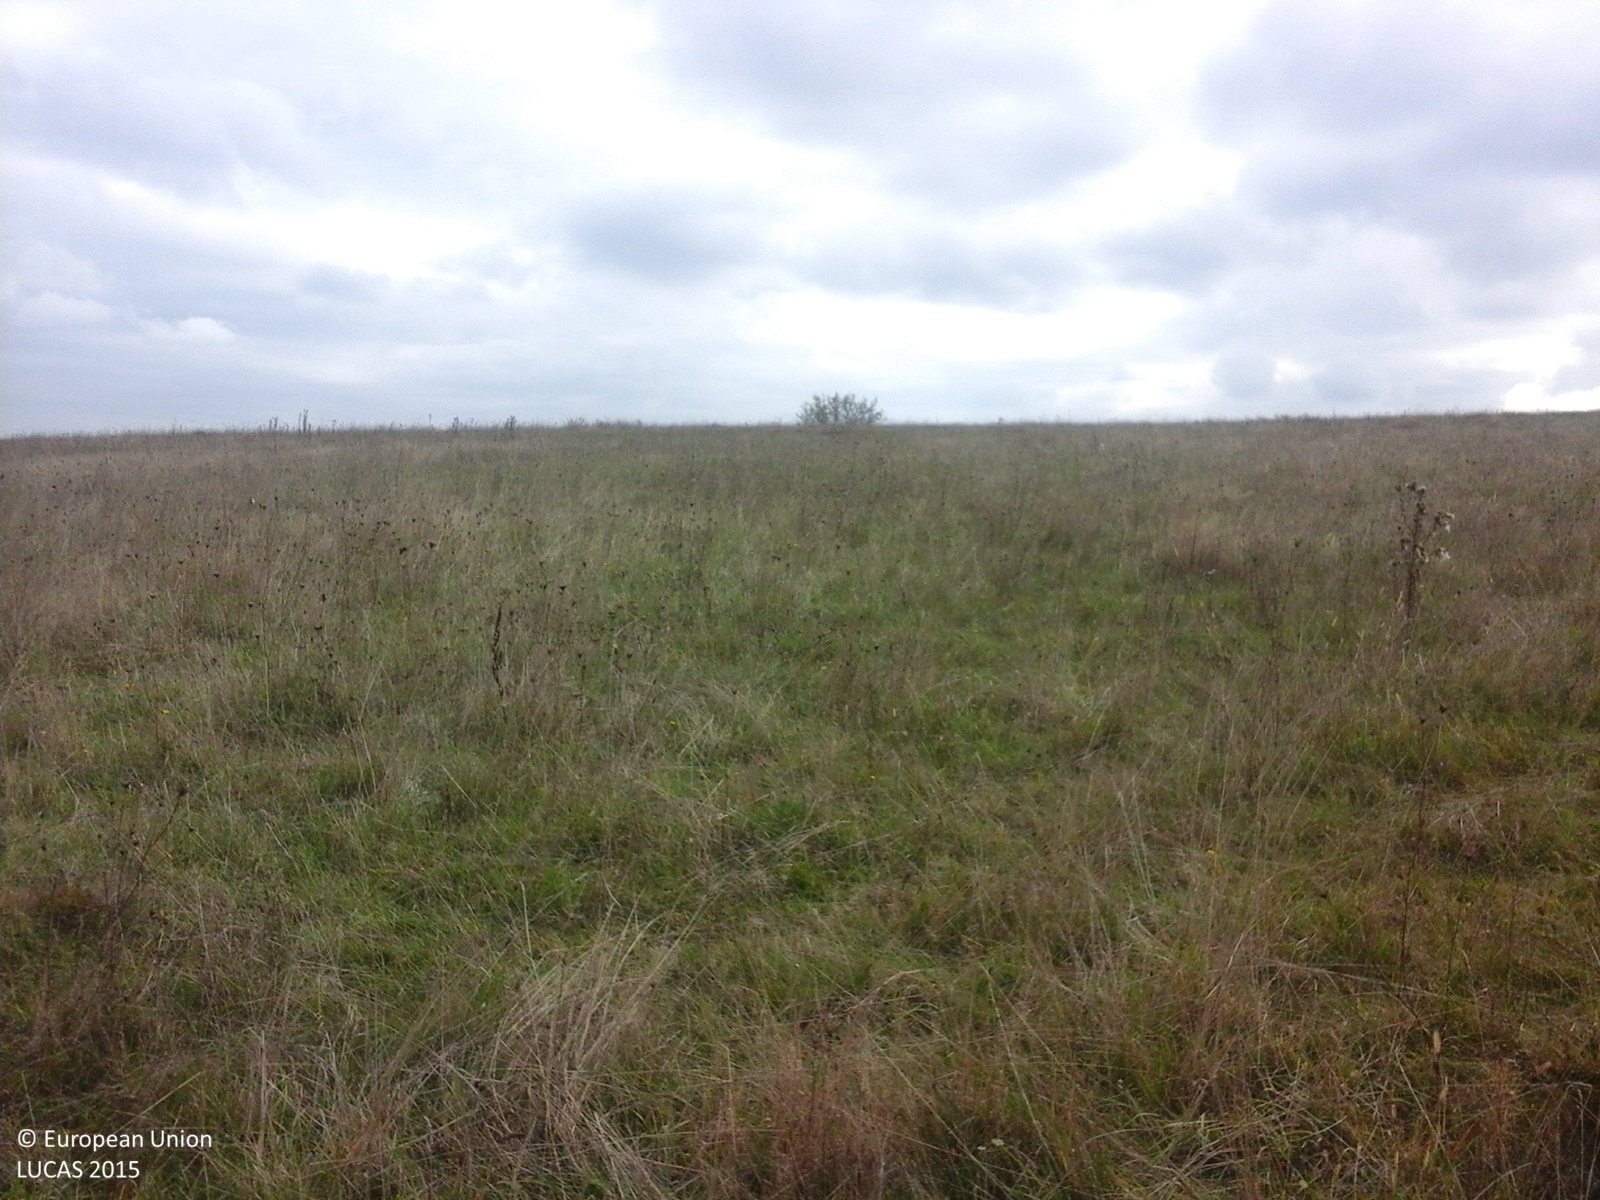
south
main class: Grassland
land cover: Grassland without tree/shrub cover
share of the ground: > 75 %
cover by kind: herbaceous plants 100 %
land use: Agriculture (excluding fallow land and kitchen gardens)
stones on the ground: < 10 %
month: October
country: RO
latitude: 45.9397
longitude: 24.6481
